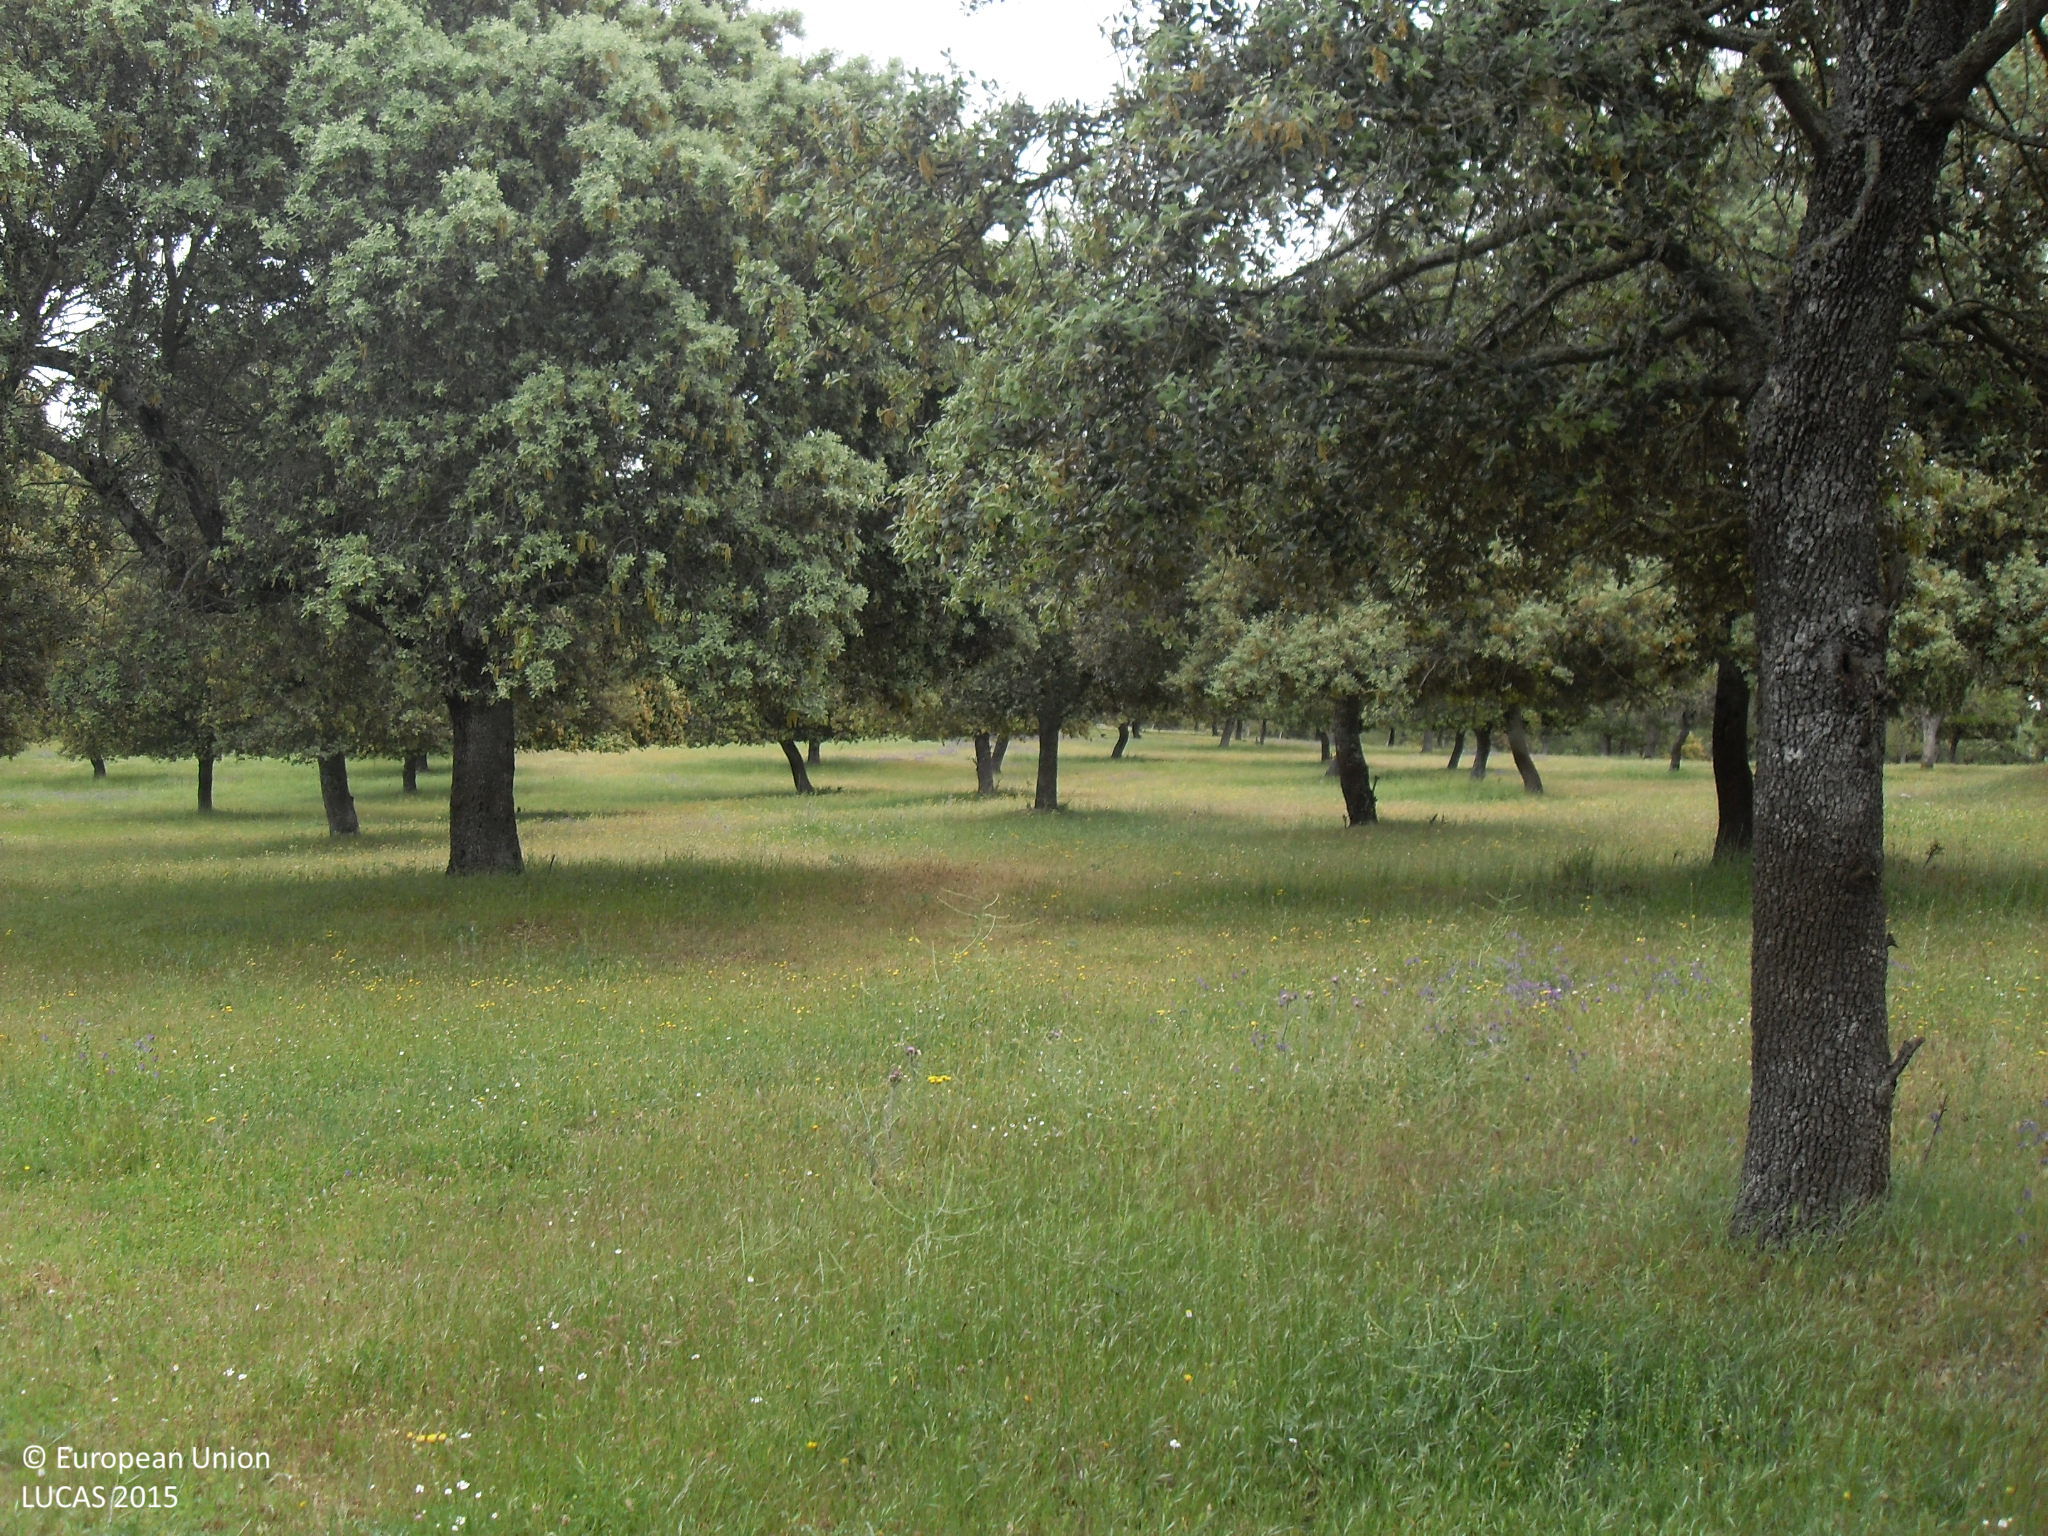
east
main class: Woodland
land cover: Broadleaved woodland
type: broadleaved evergreen forest
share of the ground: 25 - 50 %
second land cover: Grassland without tree/shrub cover
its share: 50 - 75 %
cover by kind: herbaceous plants 55 %, broadleaved forest trees 45 %
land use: Forestry
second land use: Agriculture (excluding fallow land and kitchen gardens)
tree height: > 5 m
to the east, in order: Broadleaved woodland; Grassland without tree/shrub cover
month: May
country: ES
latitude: 40.7103
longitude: -5.6626
